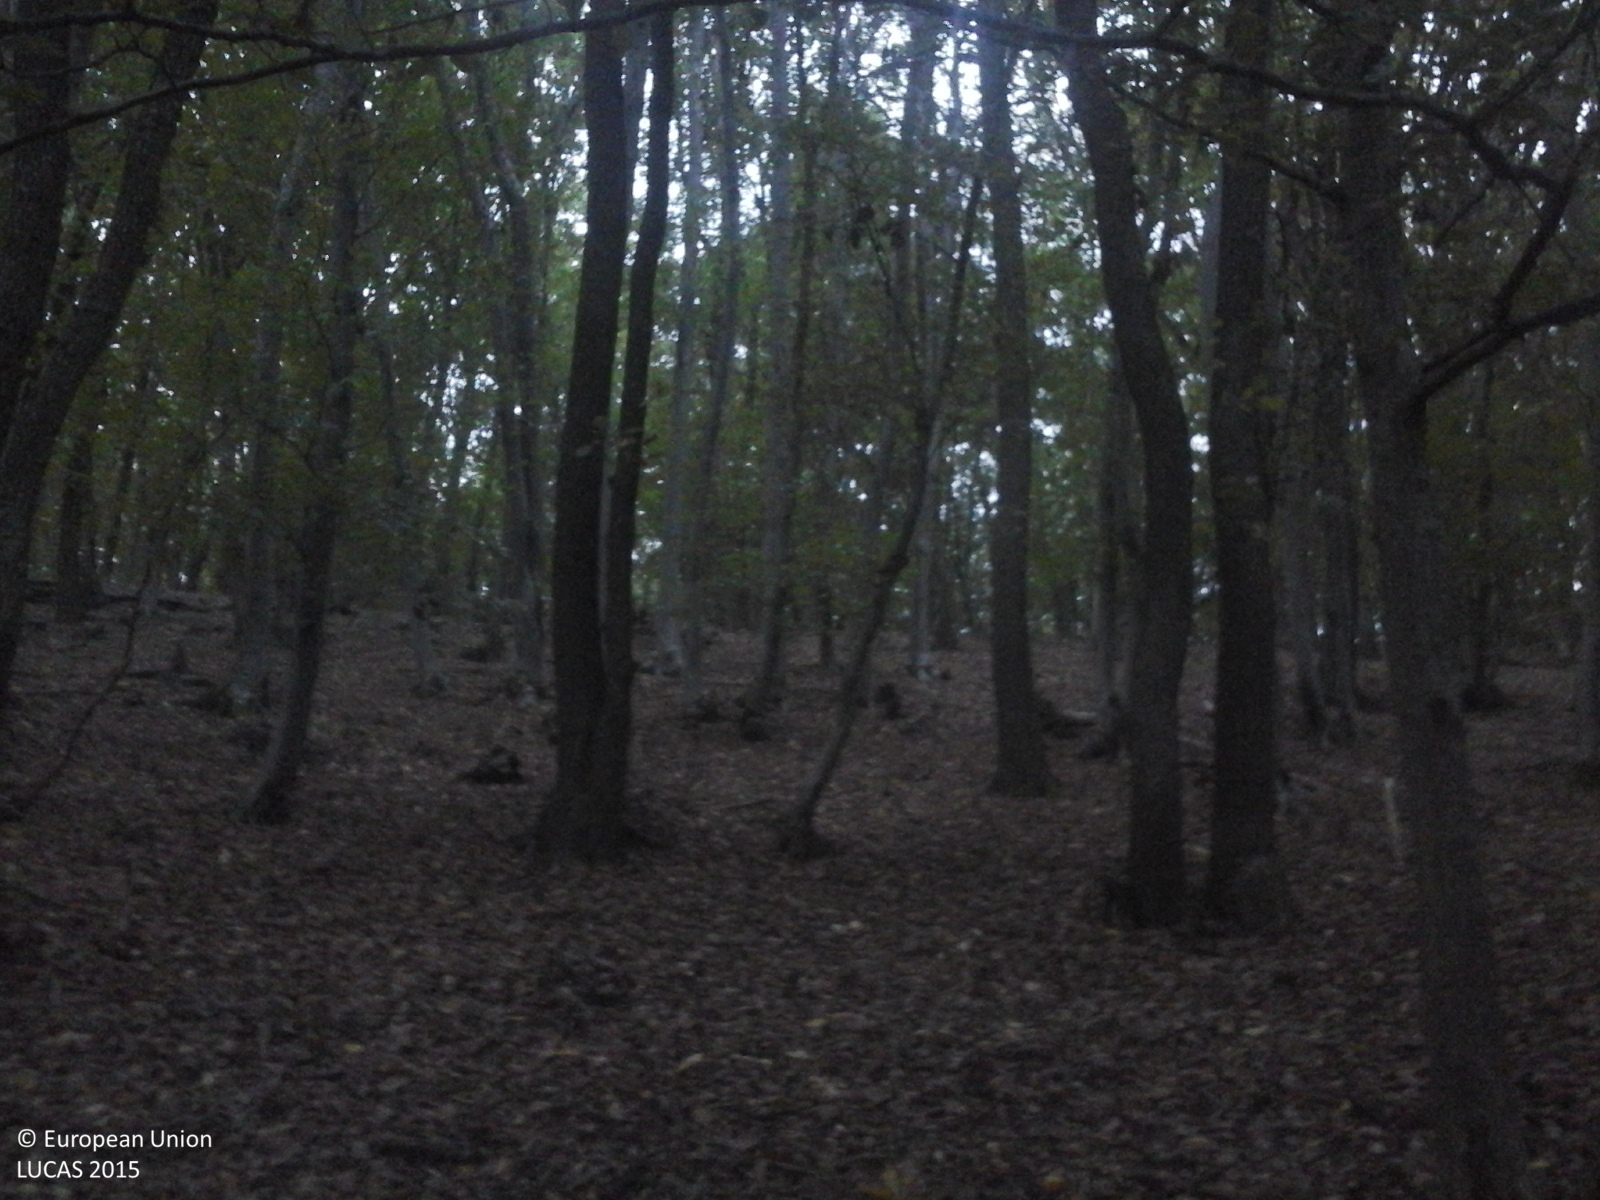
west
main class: Woodland
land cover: Broadleaved woodland
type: beech forest
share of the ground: > 75 %
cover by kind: broadleaved forest trees 100 %
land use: Forestry
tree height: > 5 m
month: October
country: RO
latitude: 46.3800
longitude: 24.7705
